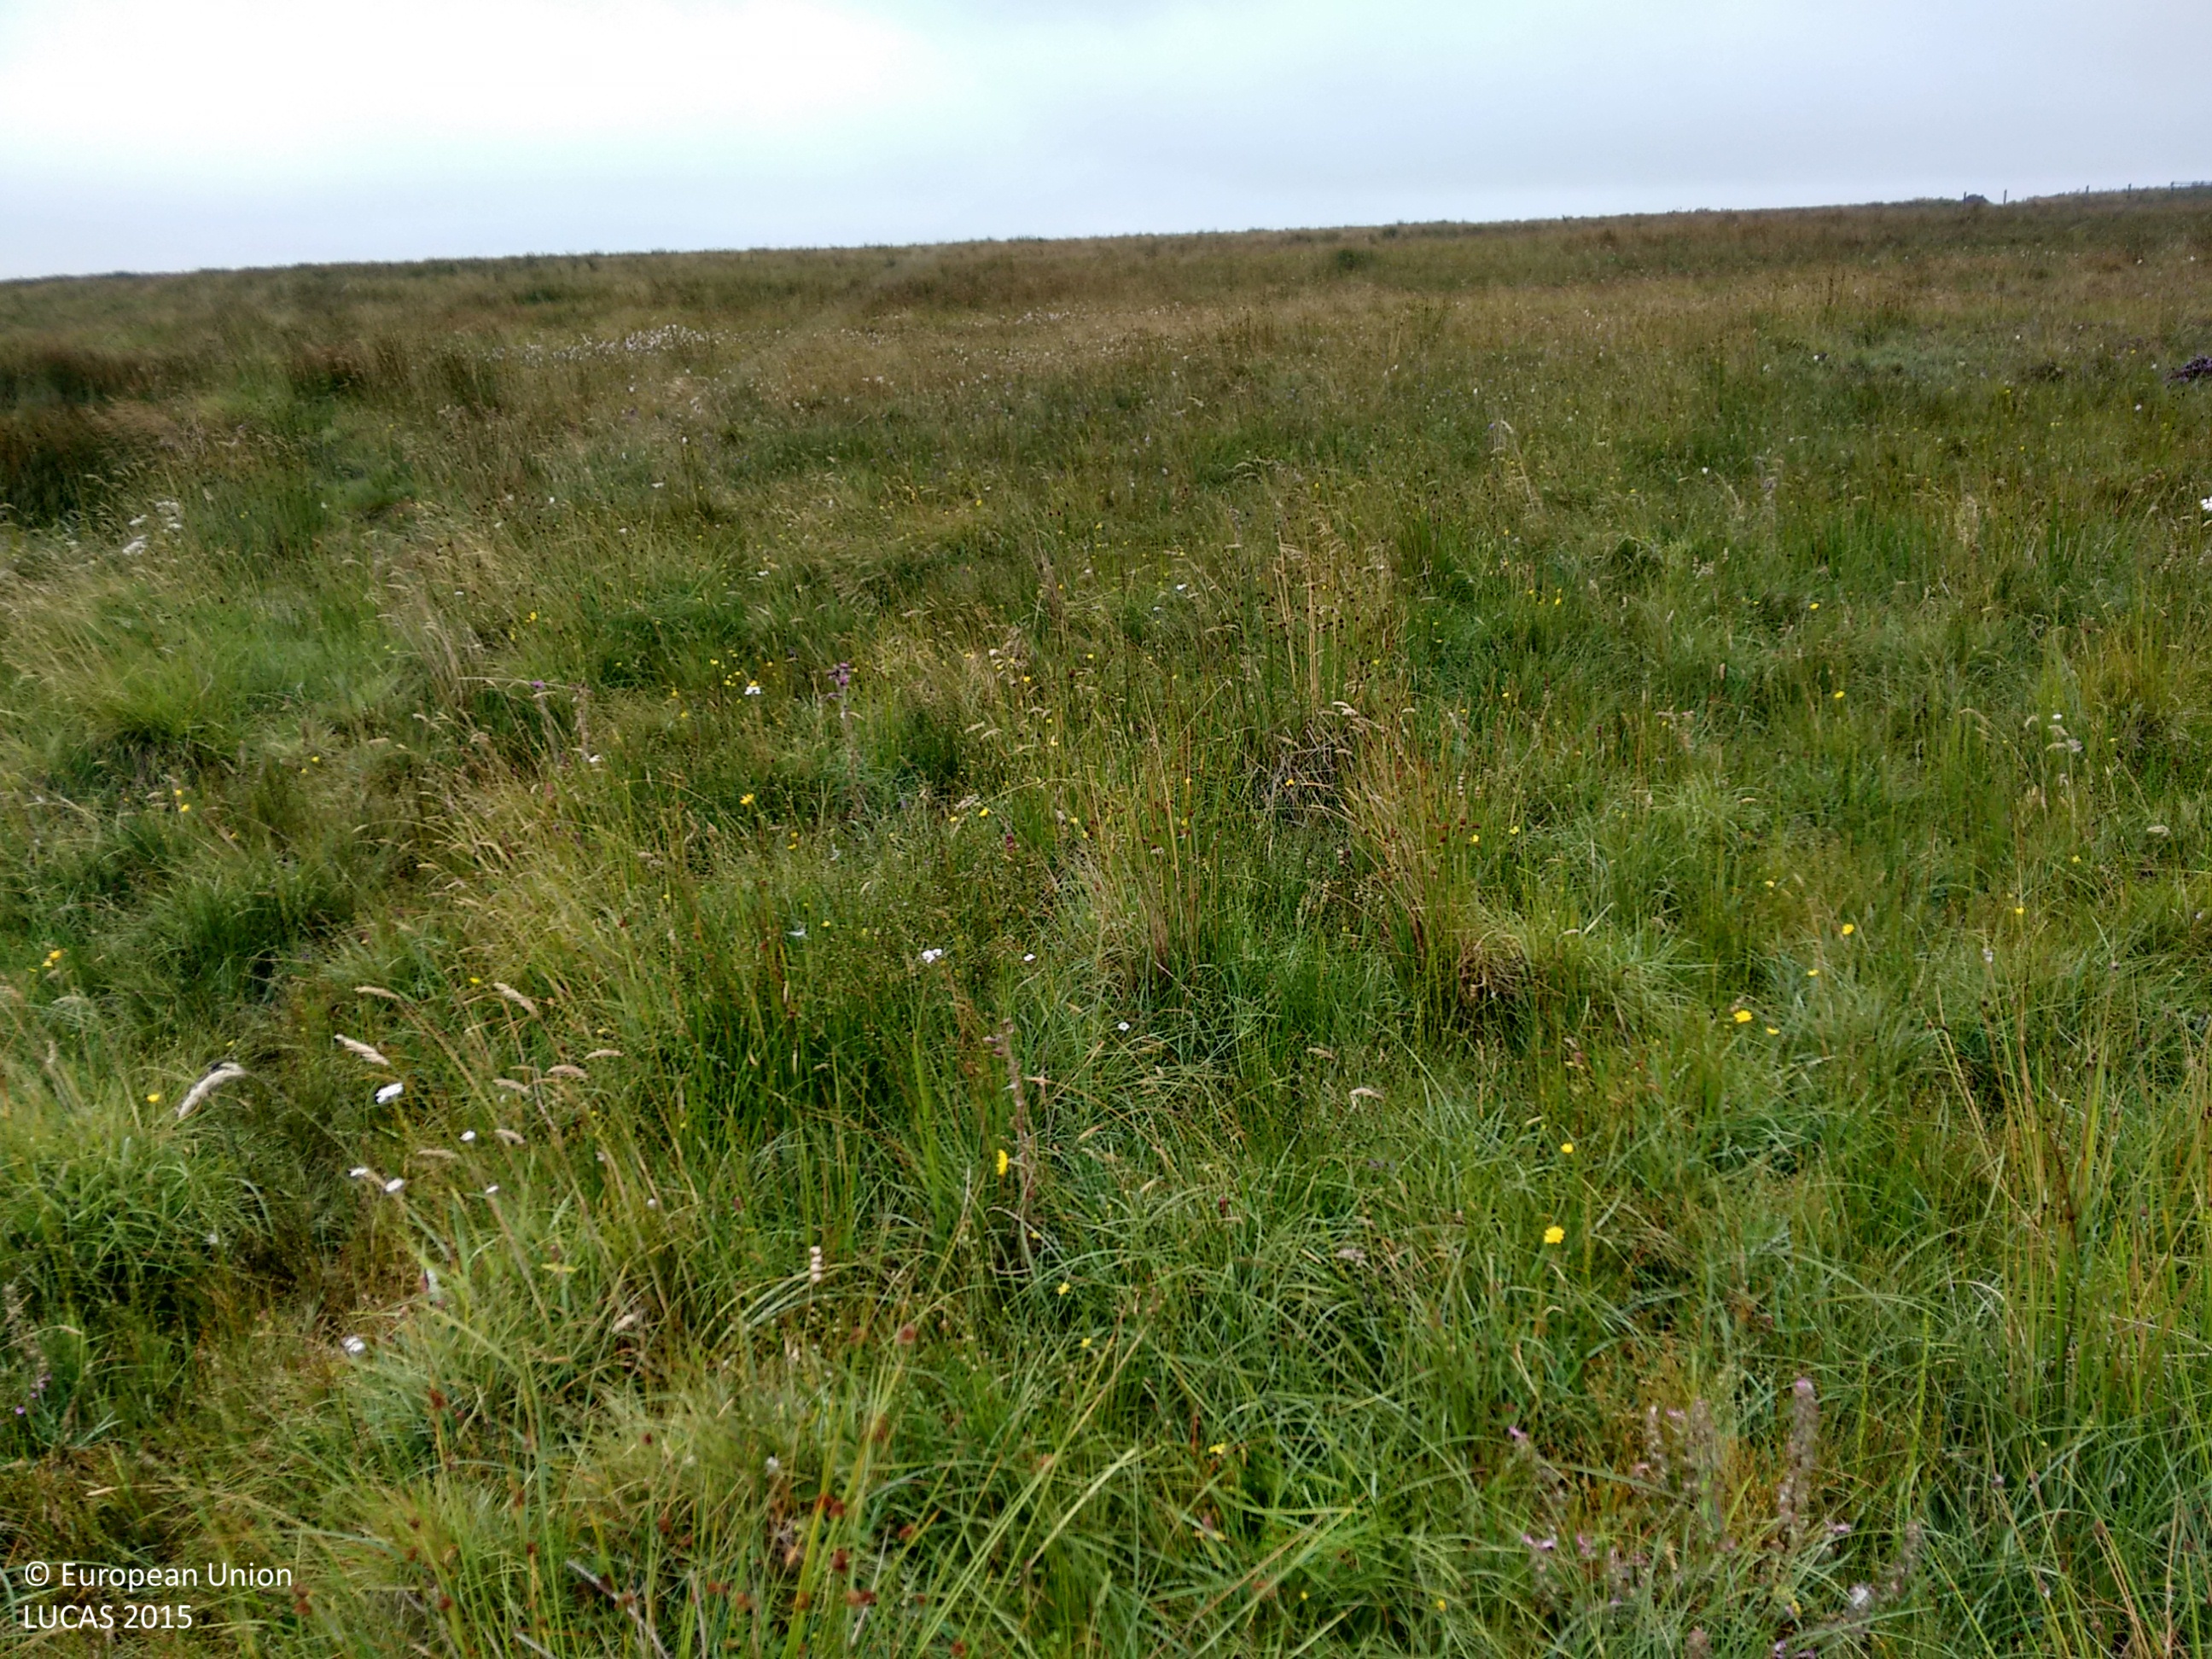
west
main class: Grassland
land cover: Grassland without tree/shrub cover
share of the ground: > 75 %
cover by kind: herbaceous plants 95 %, shrubs 5 %
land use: Agriculture (excluding fallow land and kitchen gardens)
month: August
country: GB
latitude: 58.5617
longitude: -3.2788
